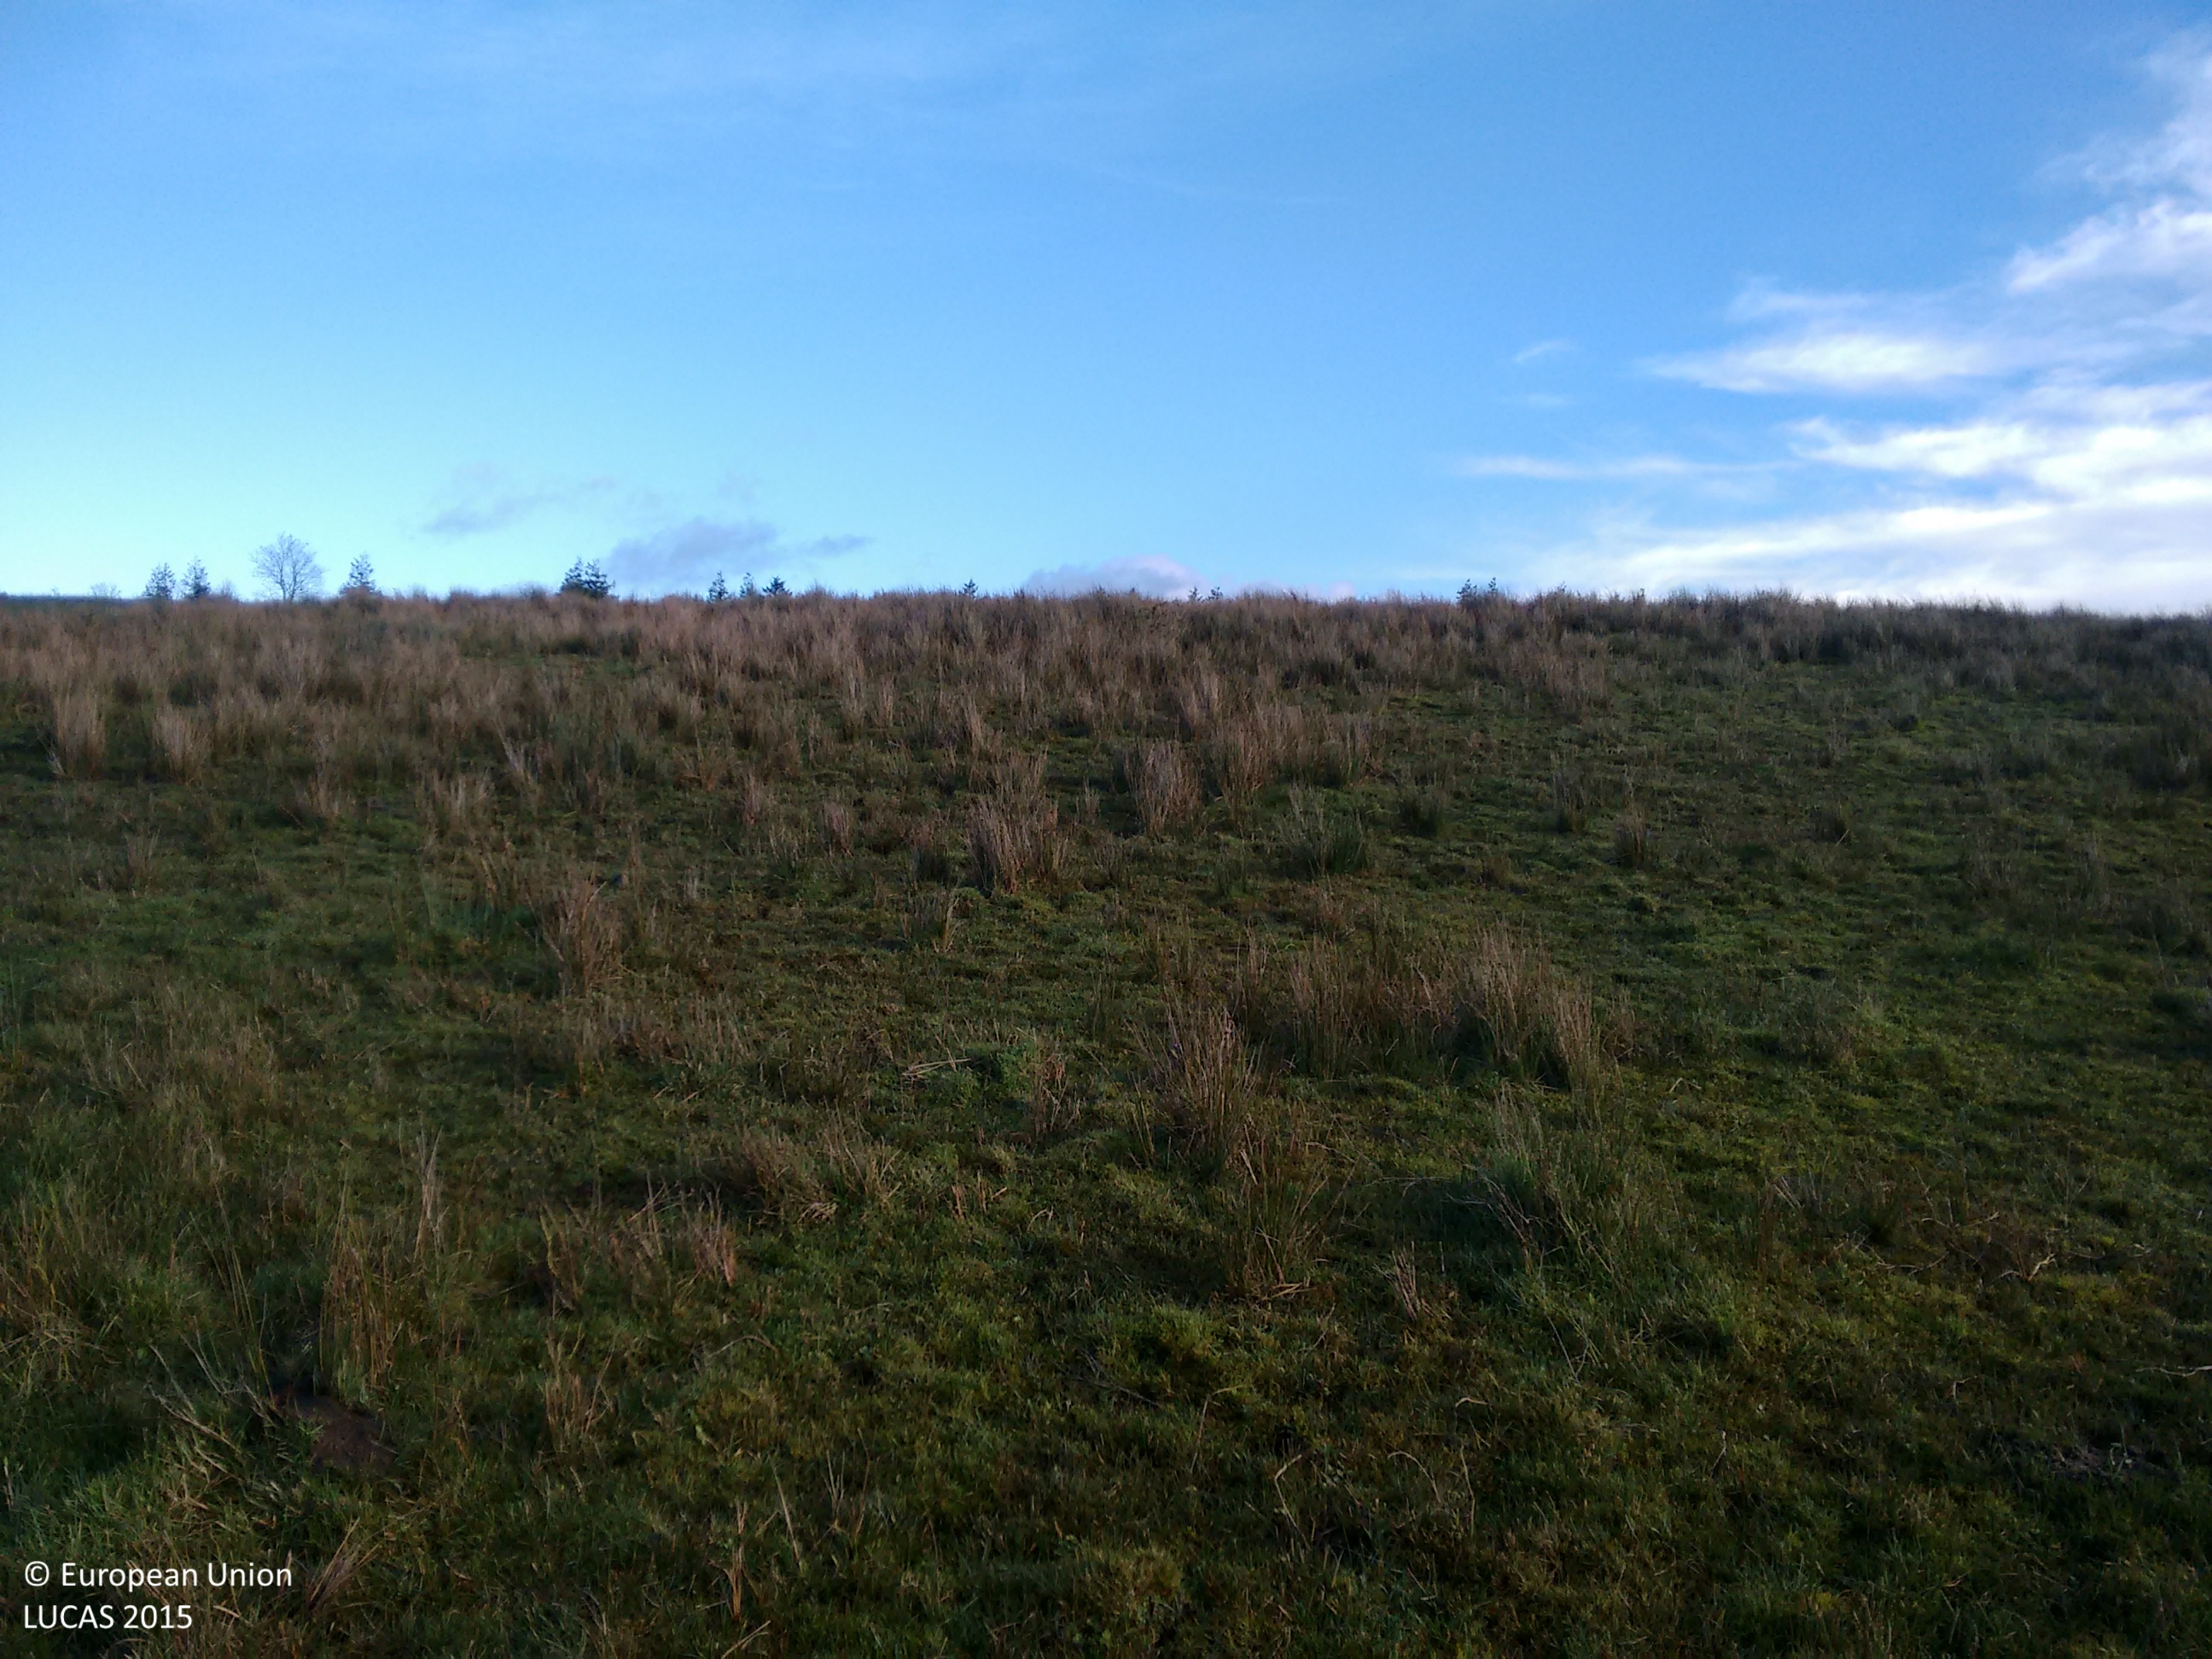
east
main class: Grassland
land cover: Grassland without tree/shrub cover
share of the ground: > 75 %
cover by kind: herbaceous plants 100 %
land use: Agriculture (excluding fallow land and kitchen gardens)
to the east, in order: Grassland without tree/shrub cover; Fences; Ditches and canals; Abandoned hedges; Dry stone walls; Grass margins; Paved roads, cycling and walking lanes; Fences; Grassland without tree/shrub cover; Electric lines; Grassland without tree/shrub cover; Electric lines; Grassland without tree/shrub cover
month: November
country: IE
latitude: 54.0445
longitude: -7.9014
